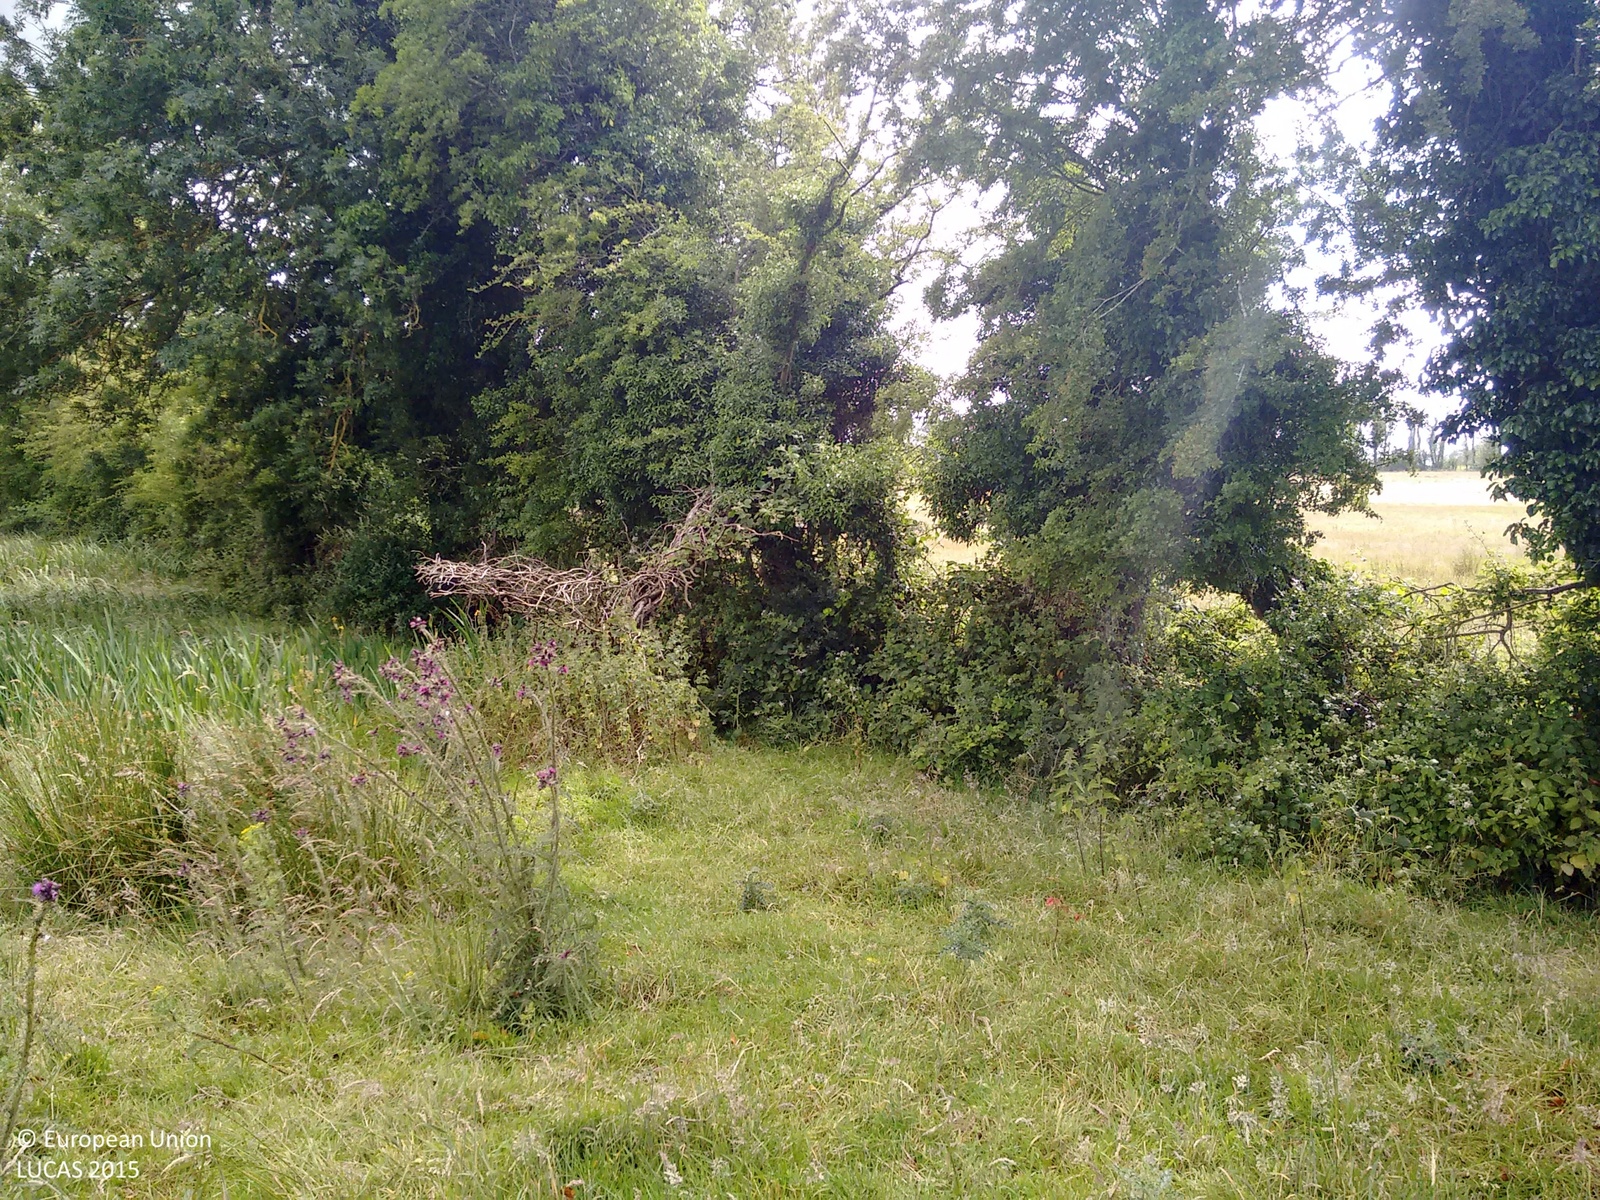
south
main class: Grassland
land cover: Grassland without tree/shrub cover
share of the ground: > 75 %
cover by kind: herbaceous plants 95 %, shrubs 5 %
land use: Agriculture (excluding fallow land and kitchen gardens)
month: July
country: IE
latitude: 53.6110
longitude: -7.7135
